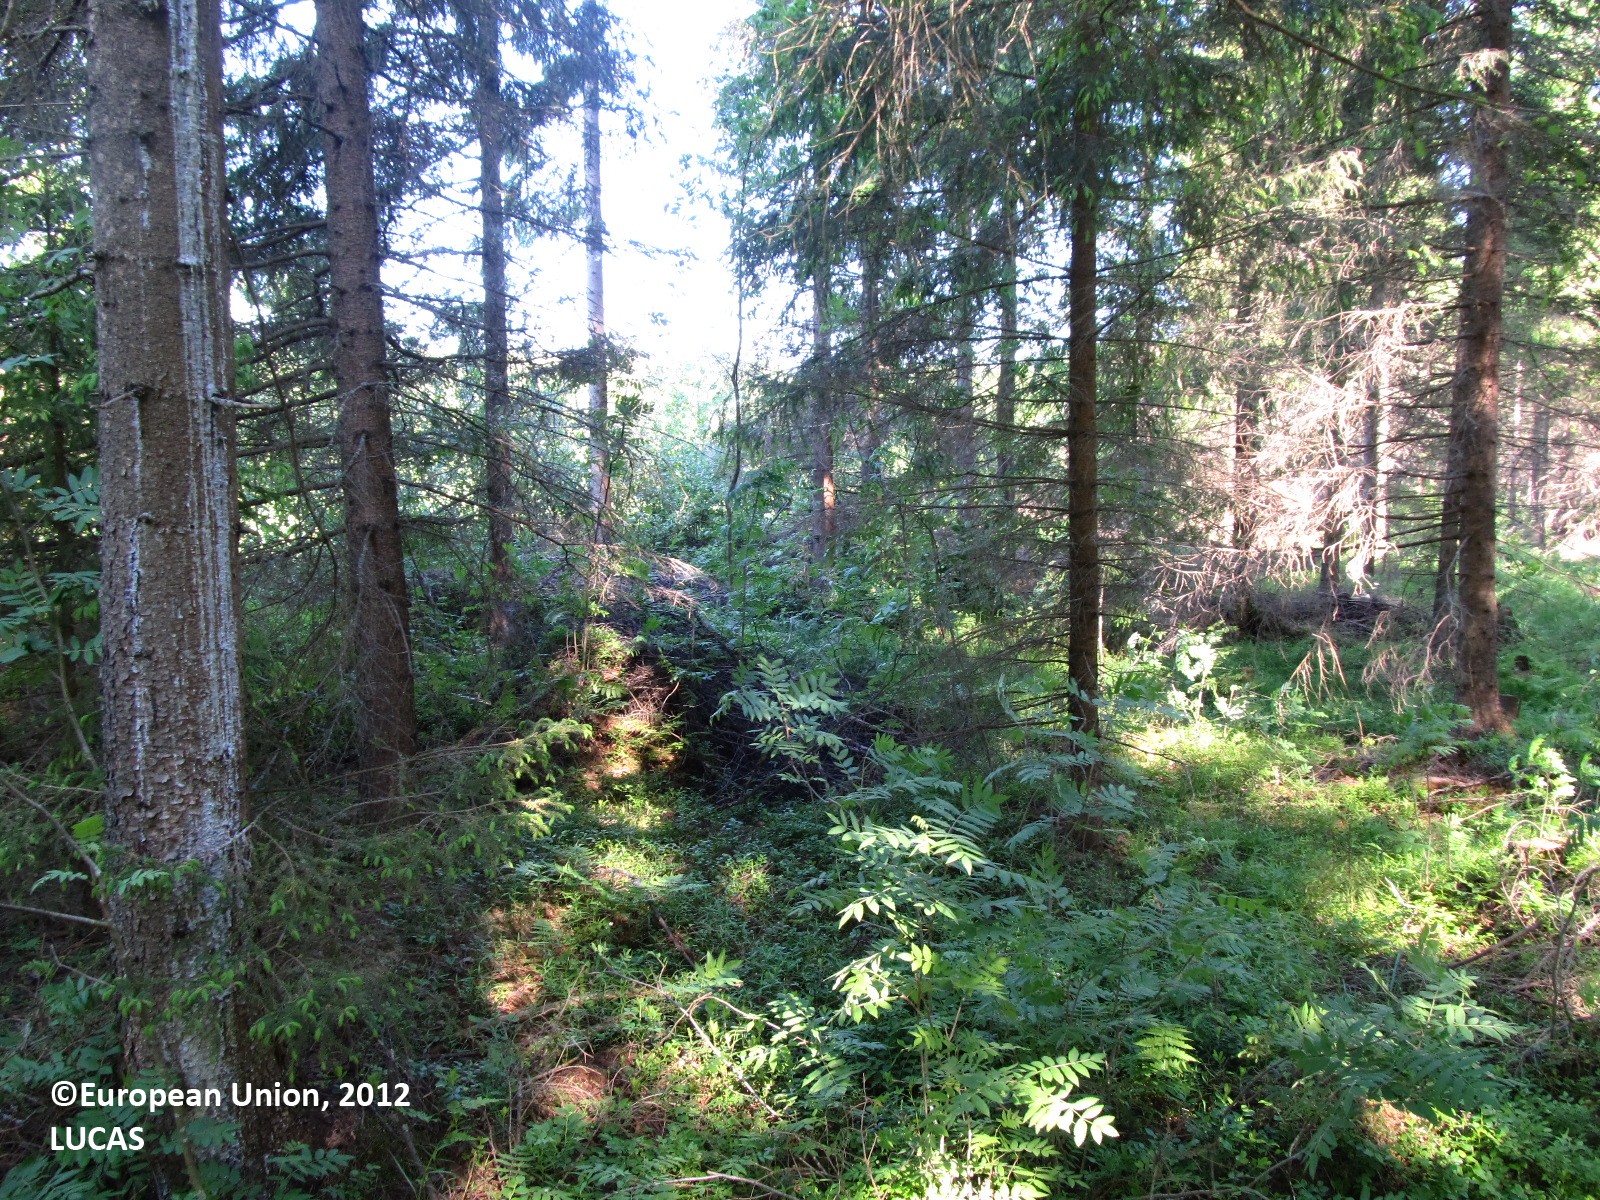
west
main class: Woodland
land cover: Spruce dominated coniferous woodland
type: boreal forest
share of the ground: 50 - 75 %
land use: Forestry
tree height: > 5 m
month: June
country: FI
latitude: 62.6801
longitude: 27.5691
